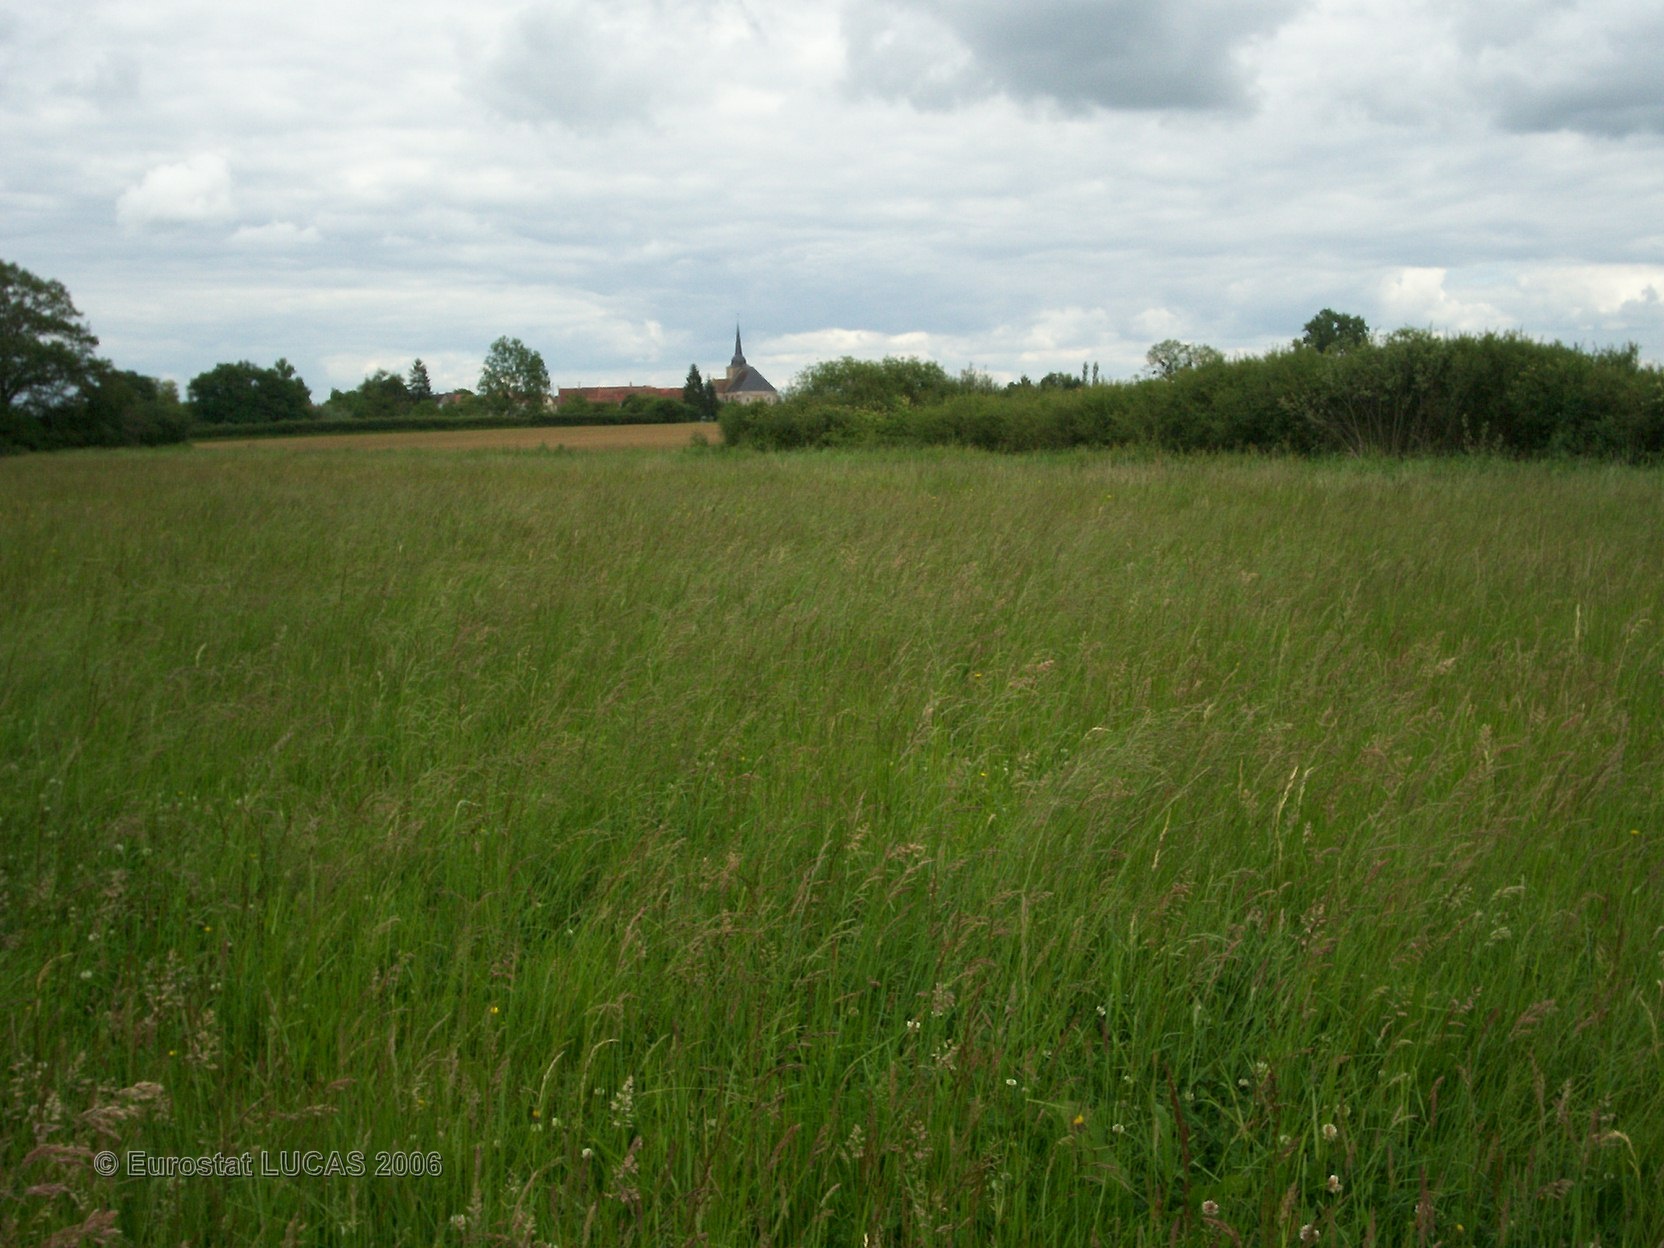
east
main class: Grassland
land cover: Grassland without tree/shrub cover
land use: Agriculture (excluding fallow land and kitchen gardens)
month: May
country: FR
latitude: 46.8648
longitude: 3.0304
